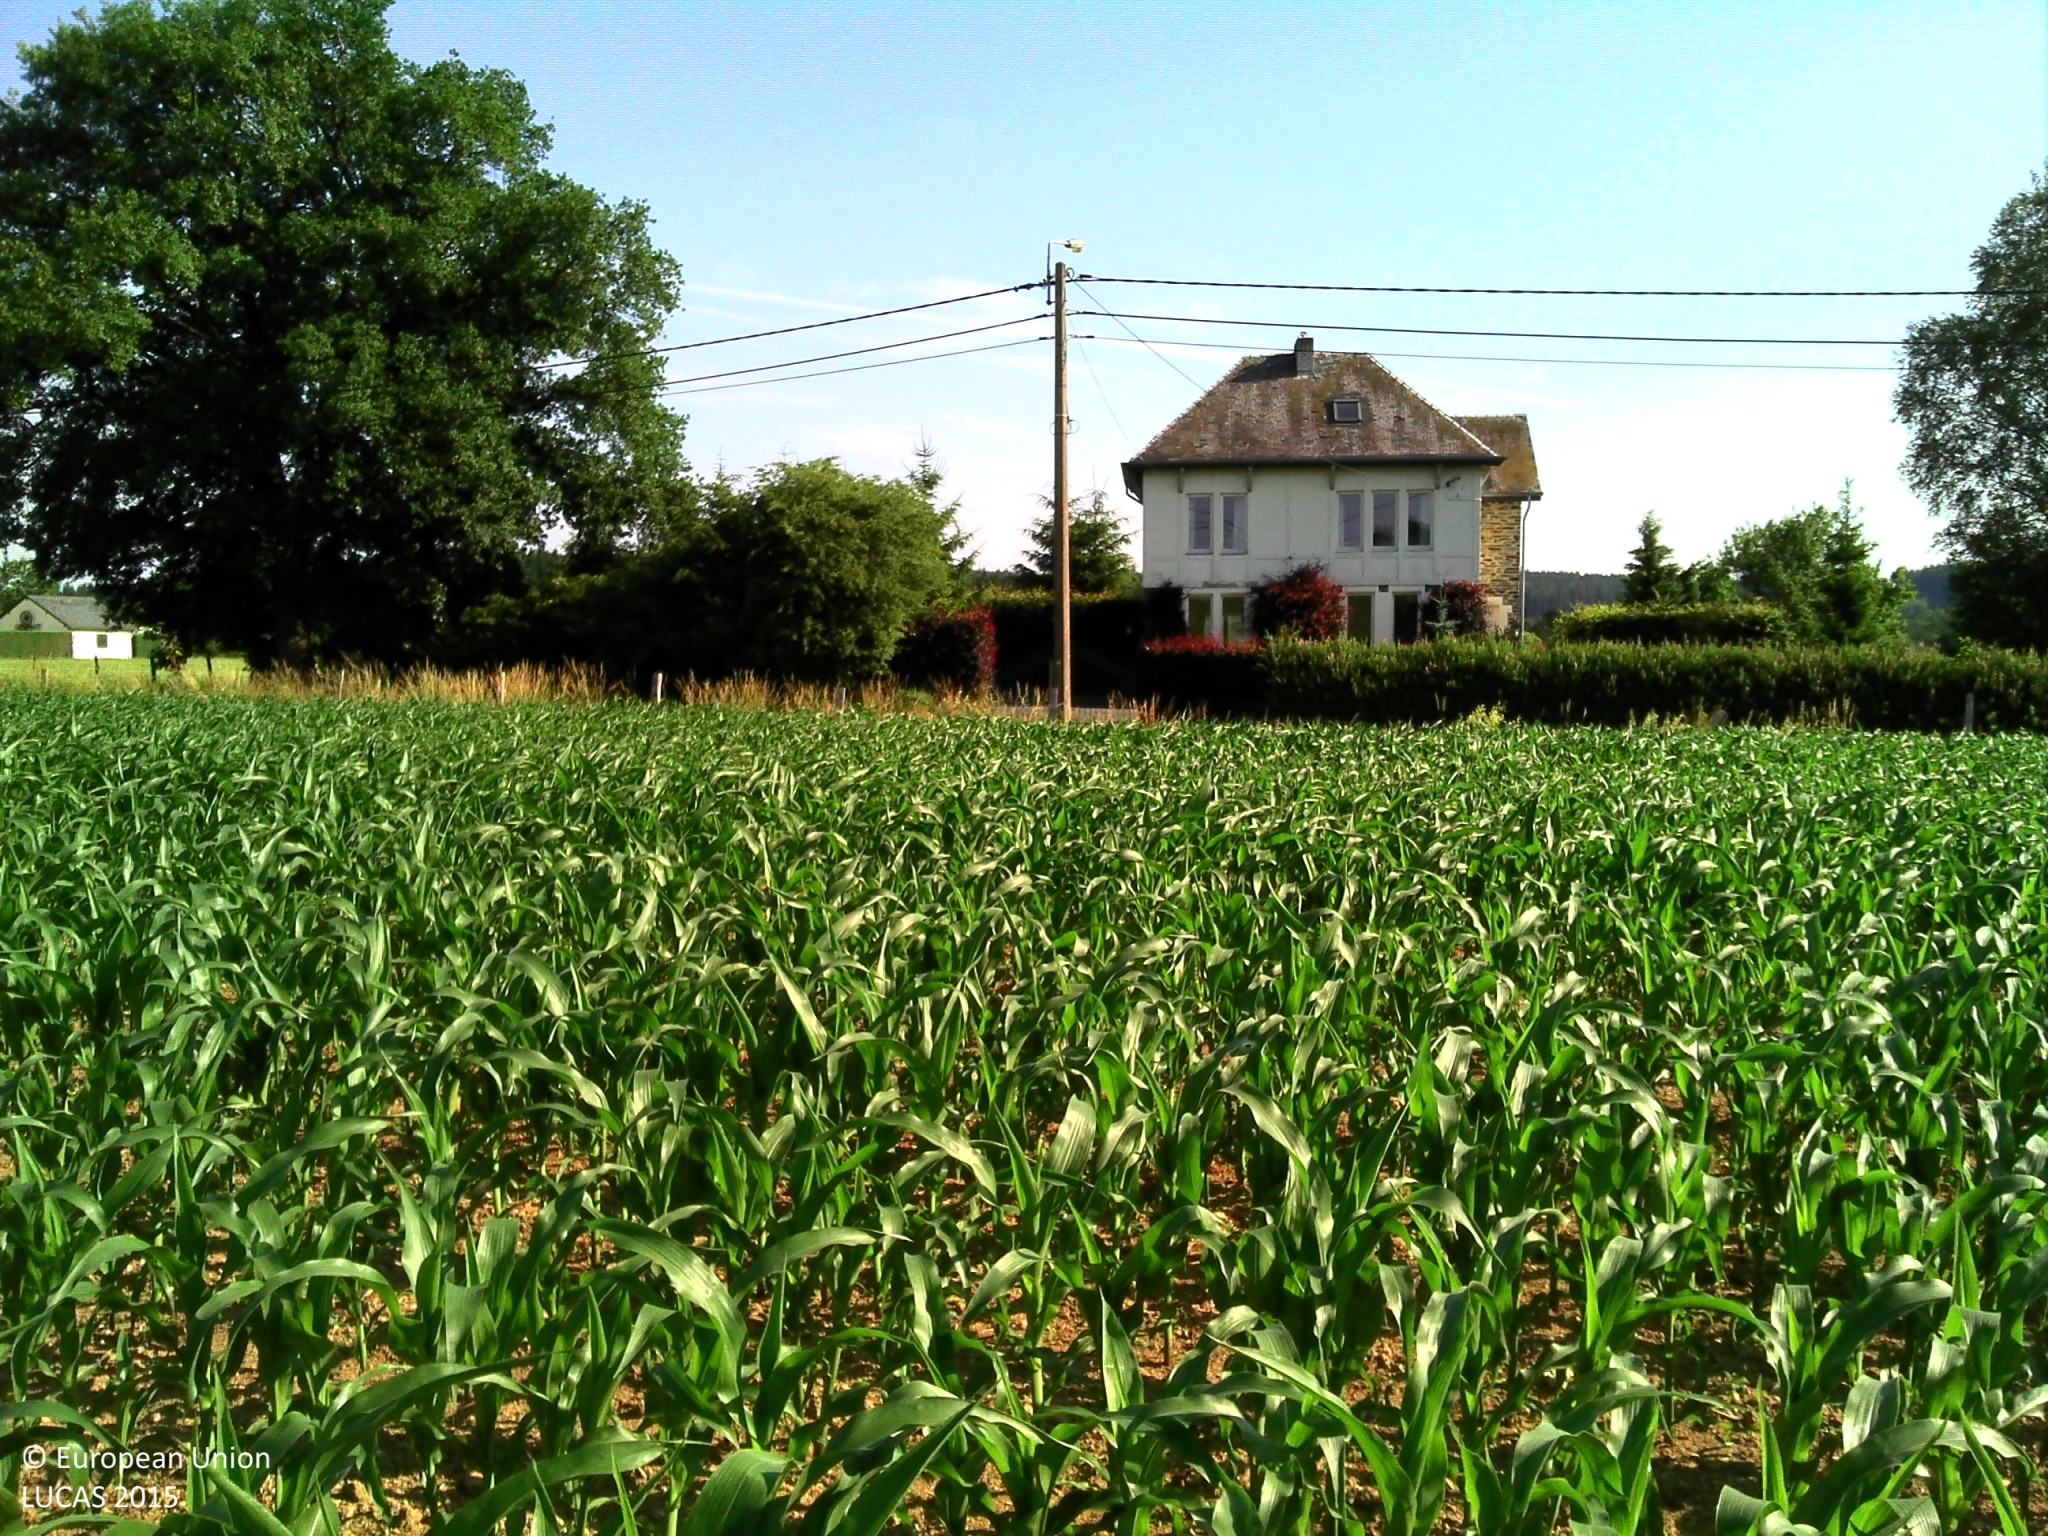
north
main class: Cropland
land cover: Maize
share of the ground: 50 - 75 %
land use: Agriculture (excluding fallow land and kitchen gardens)
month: July
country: BE
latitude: 50.2891
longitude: 5.8583
